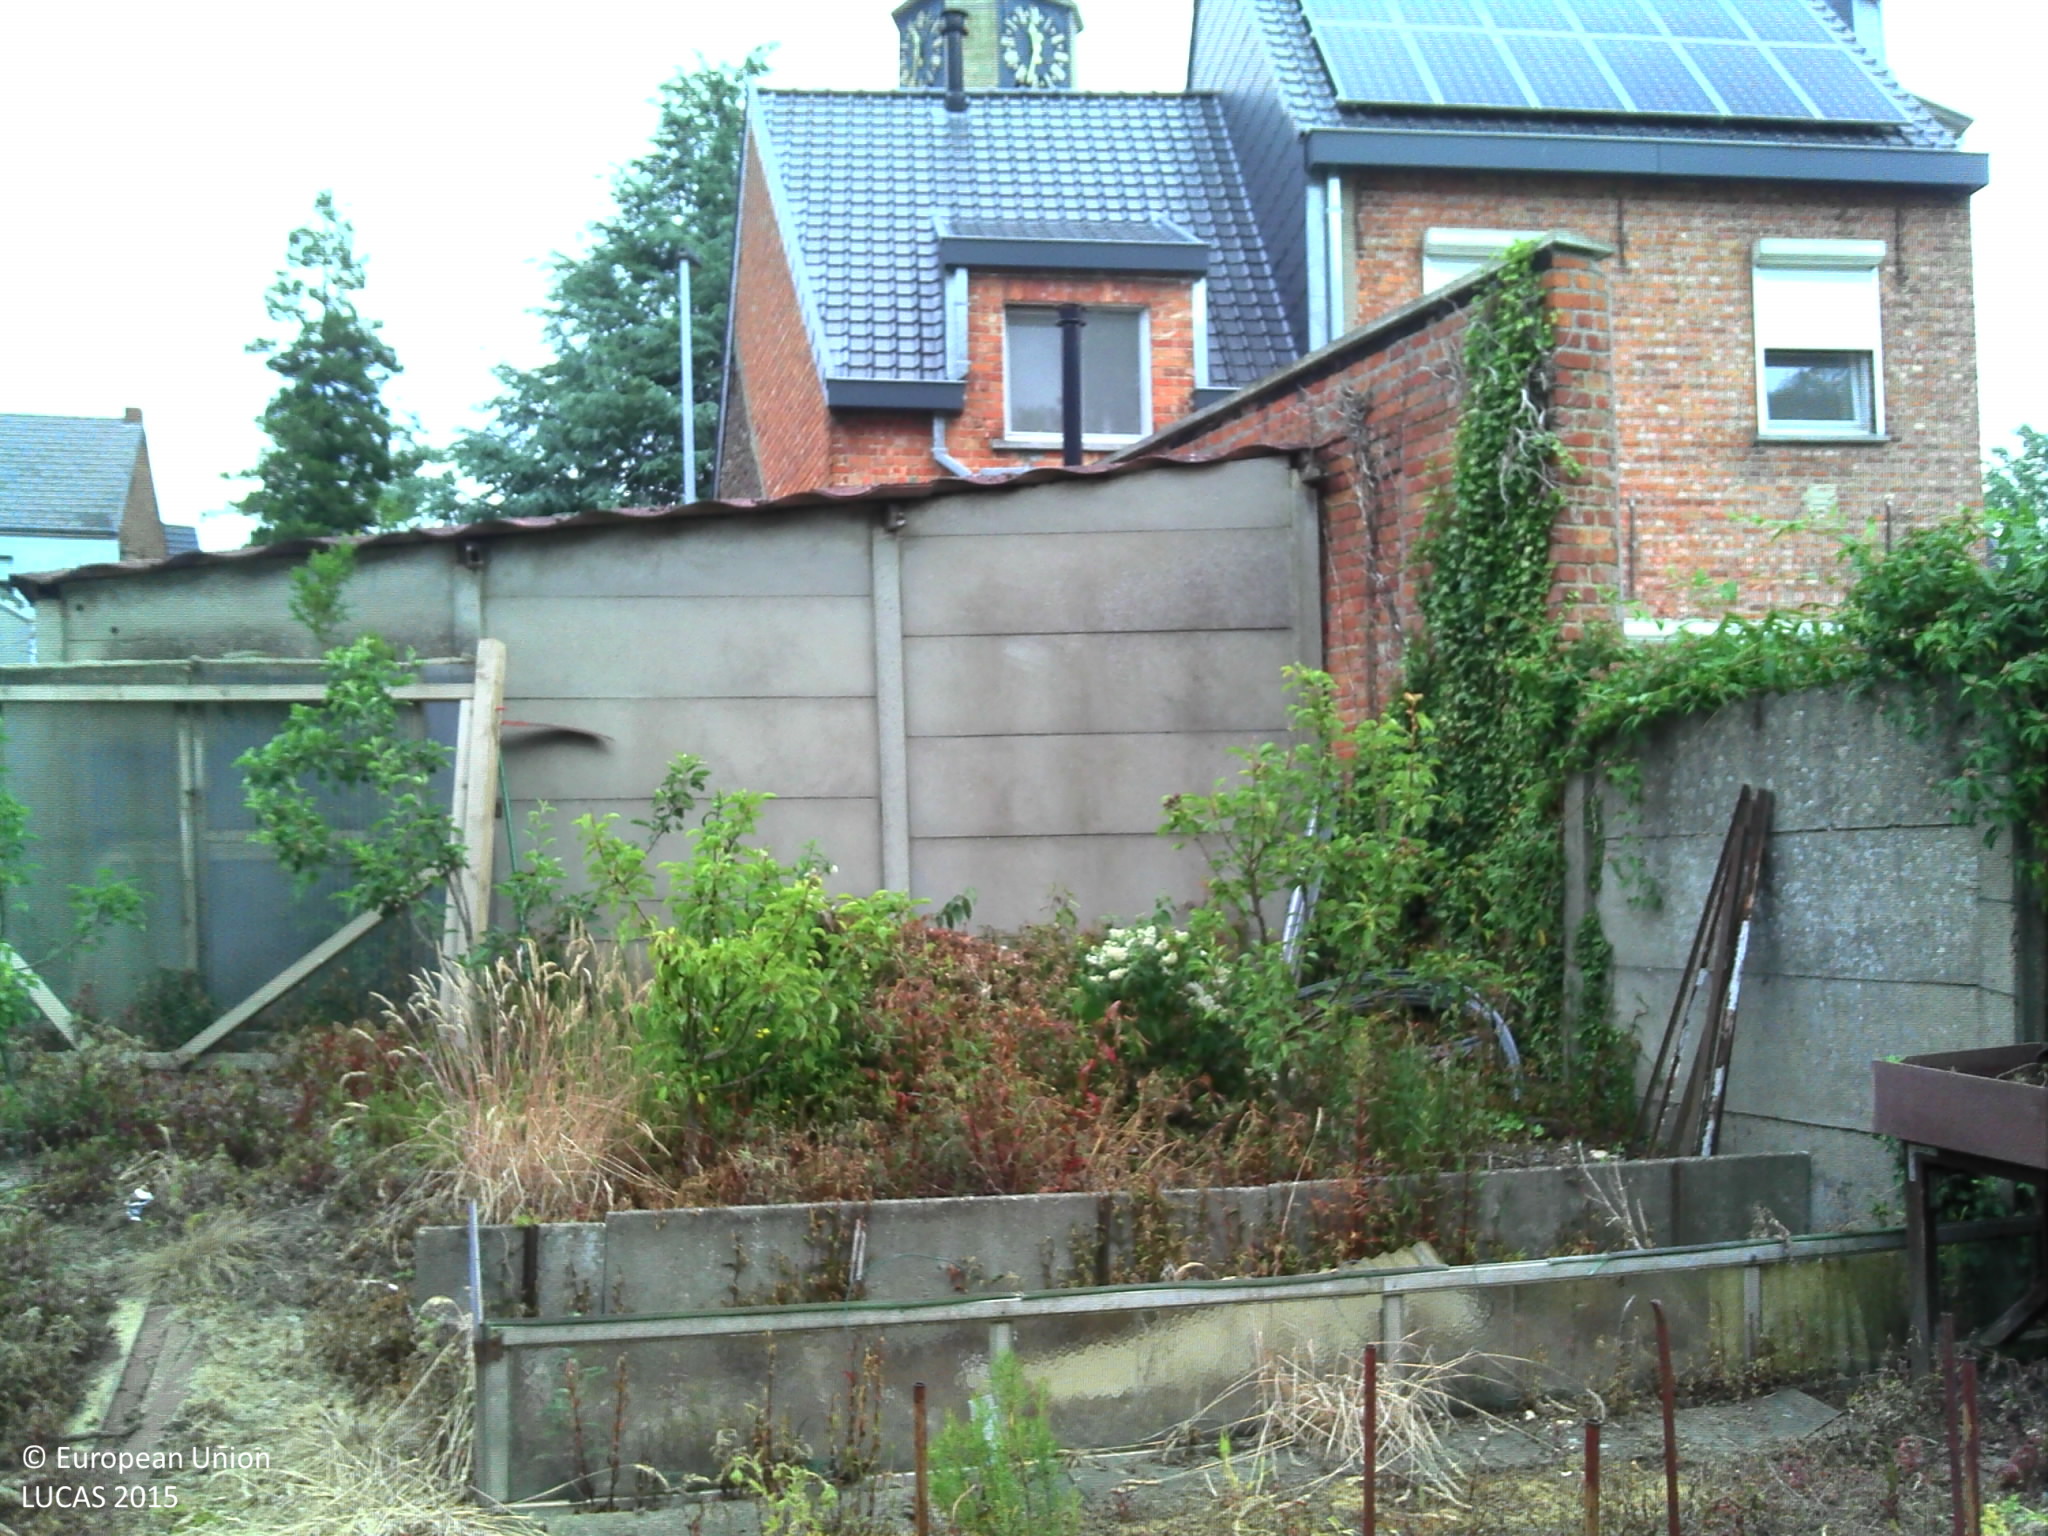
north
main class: Grassland
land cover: Spontaneously vegetated surfaces
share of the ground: > 75 %
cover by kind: herbaceous plants 70 %, lichens and mosses 30 %
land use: Residential
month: June
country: BE
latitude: 50.9847
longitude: 4.0542
